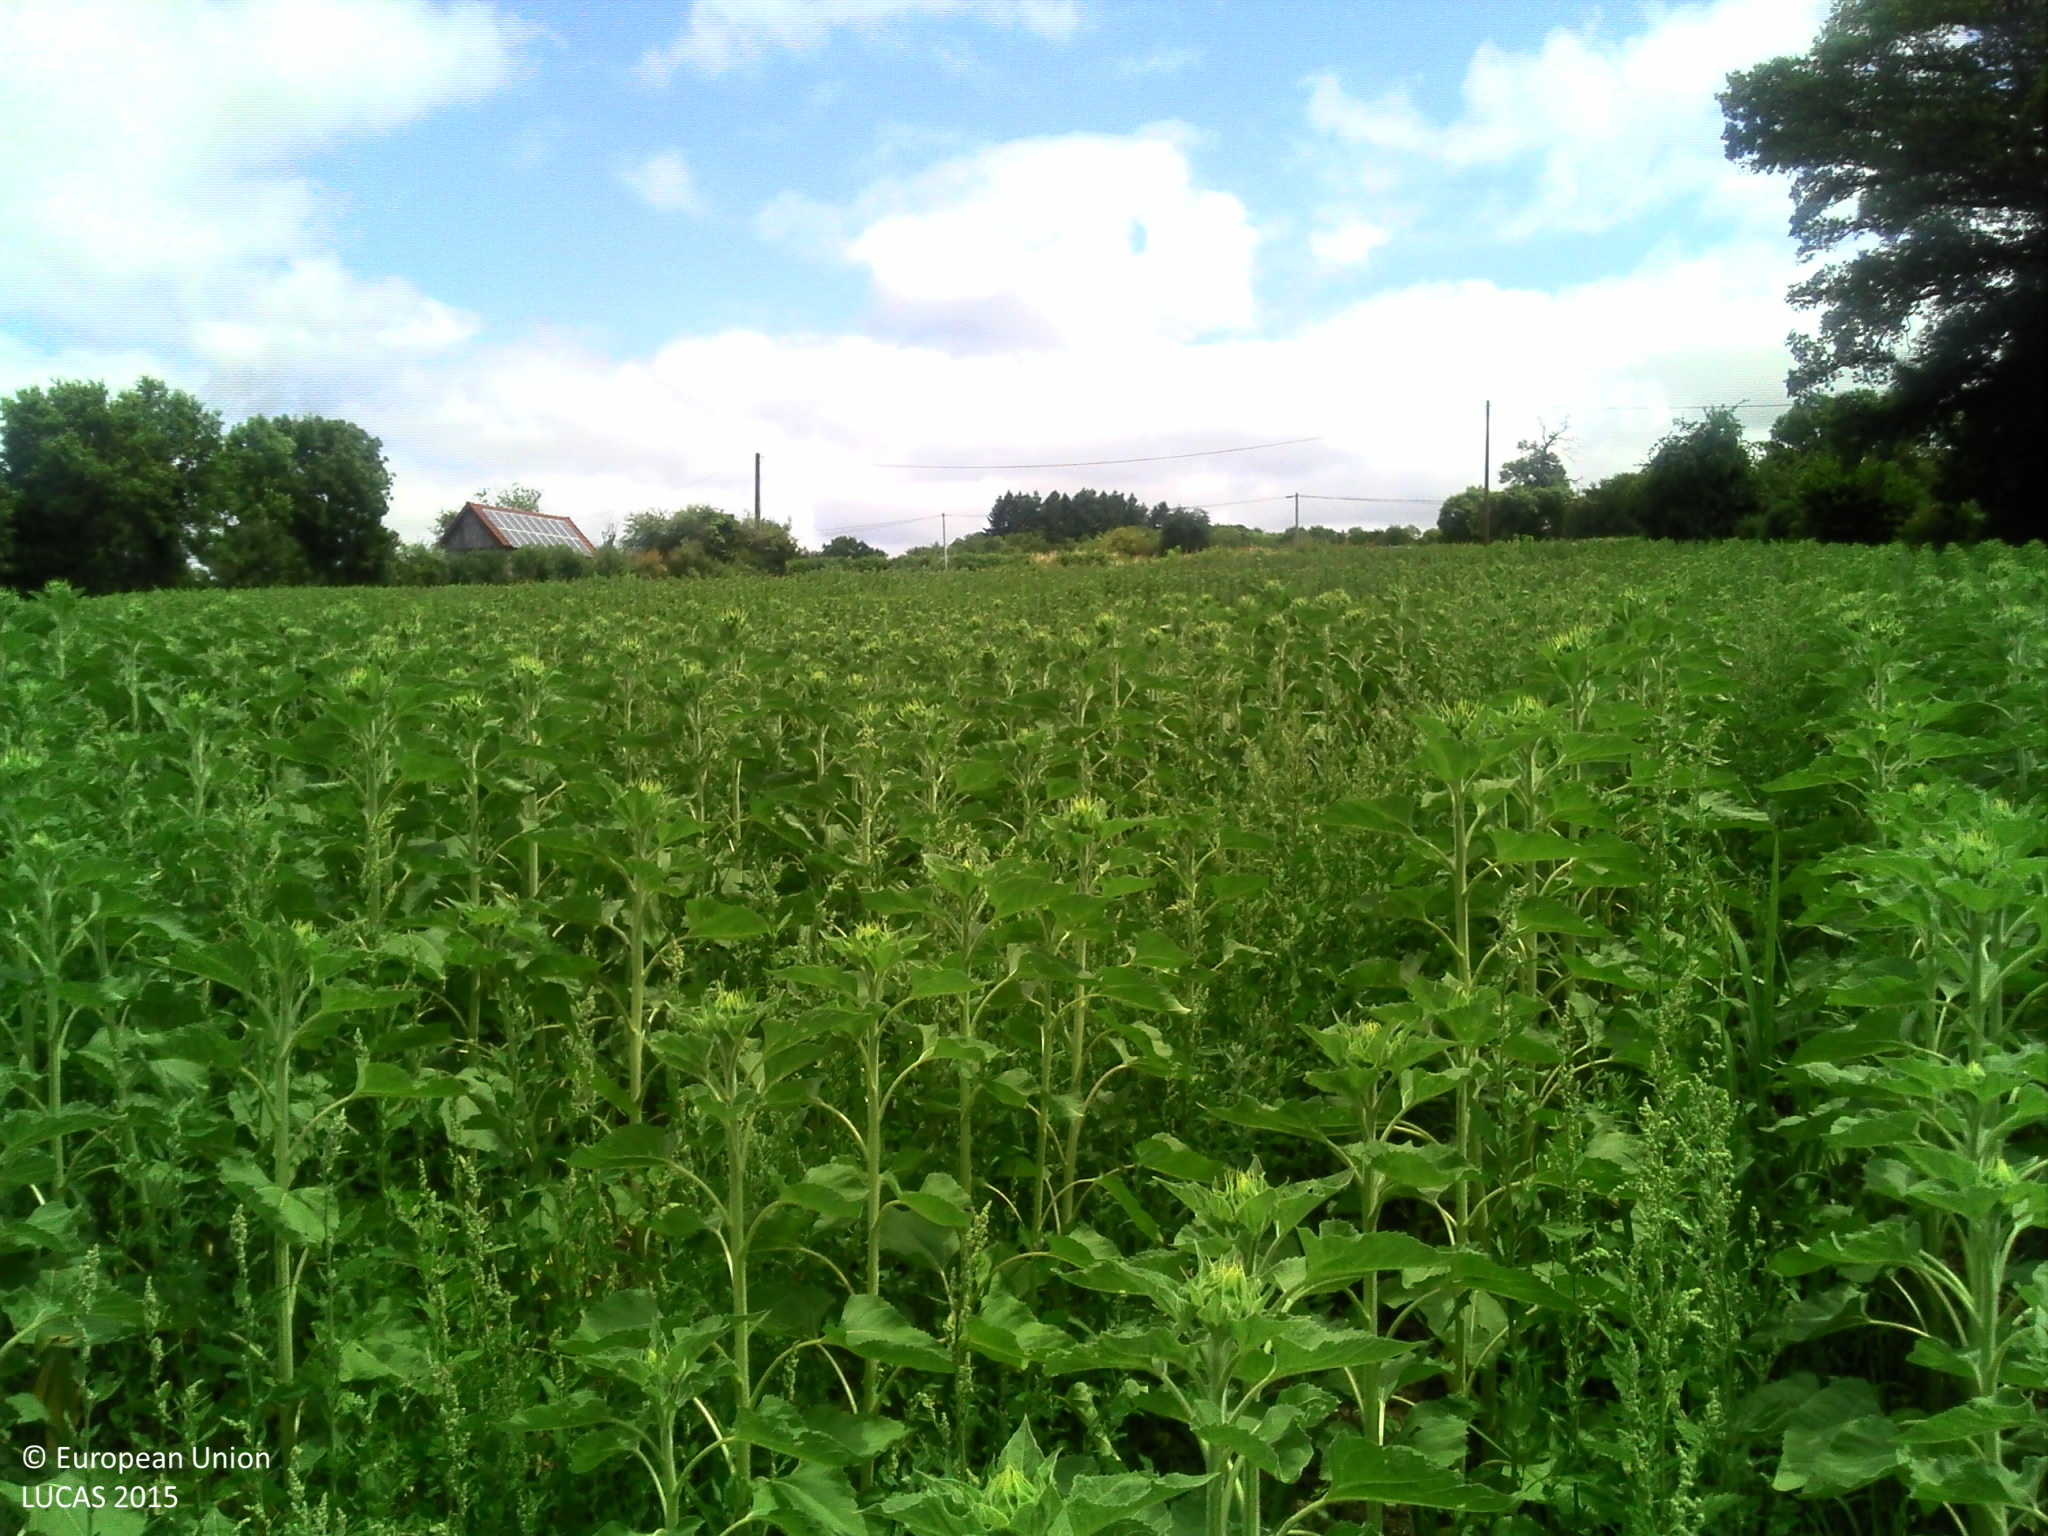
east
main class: Cropland
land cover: Sunflower
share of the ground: > 75 %
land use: Agriculture (excluding fallow land and kitchen gardens)
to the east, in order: Sunflower; Shruby margins; Electric lines; Grass margins; Paved roads, cycling and walking lanes; Ditches and canals; Electric lines; Grass margins; Clovers; Shruby margins; Dry stone walls; Shruby margins; Durum wheat
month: July
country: FR
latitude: 46.3649
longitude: 1.6071
